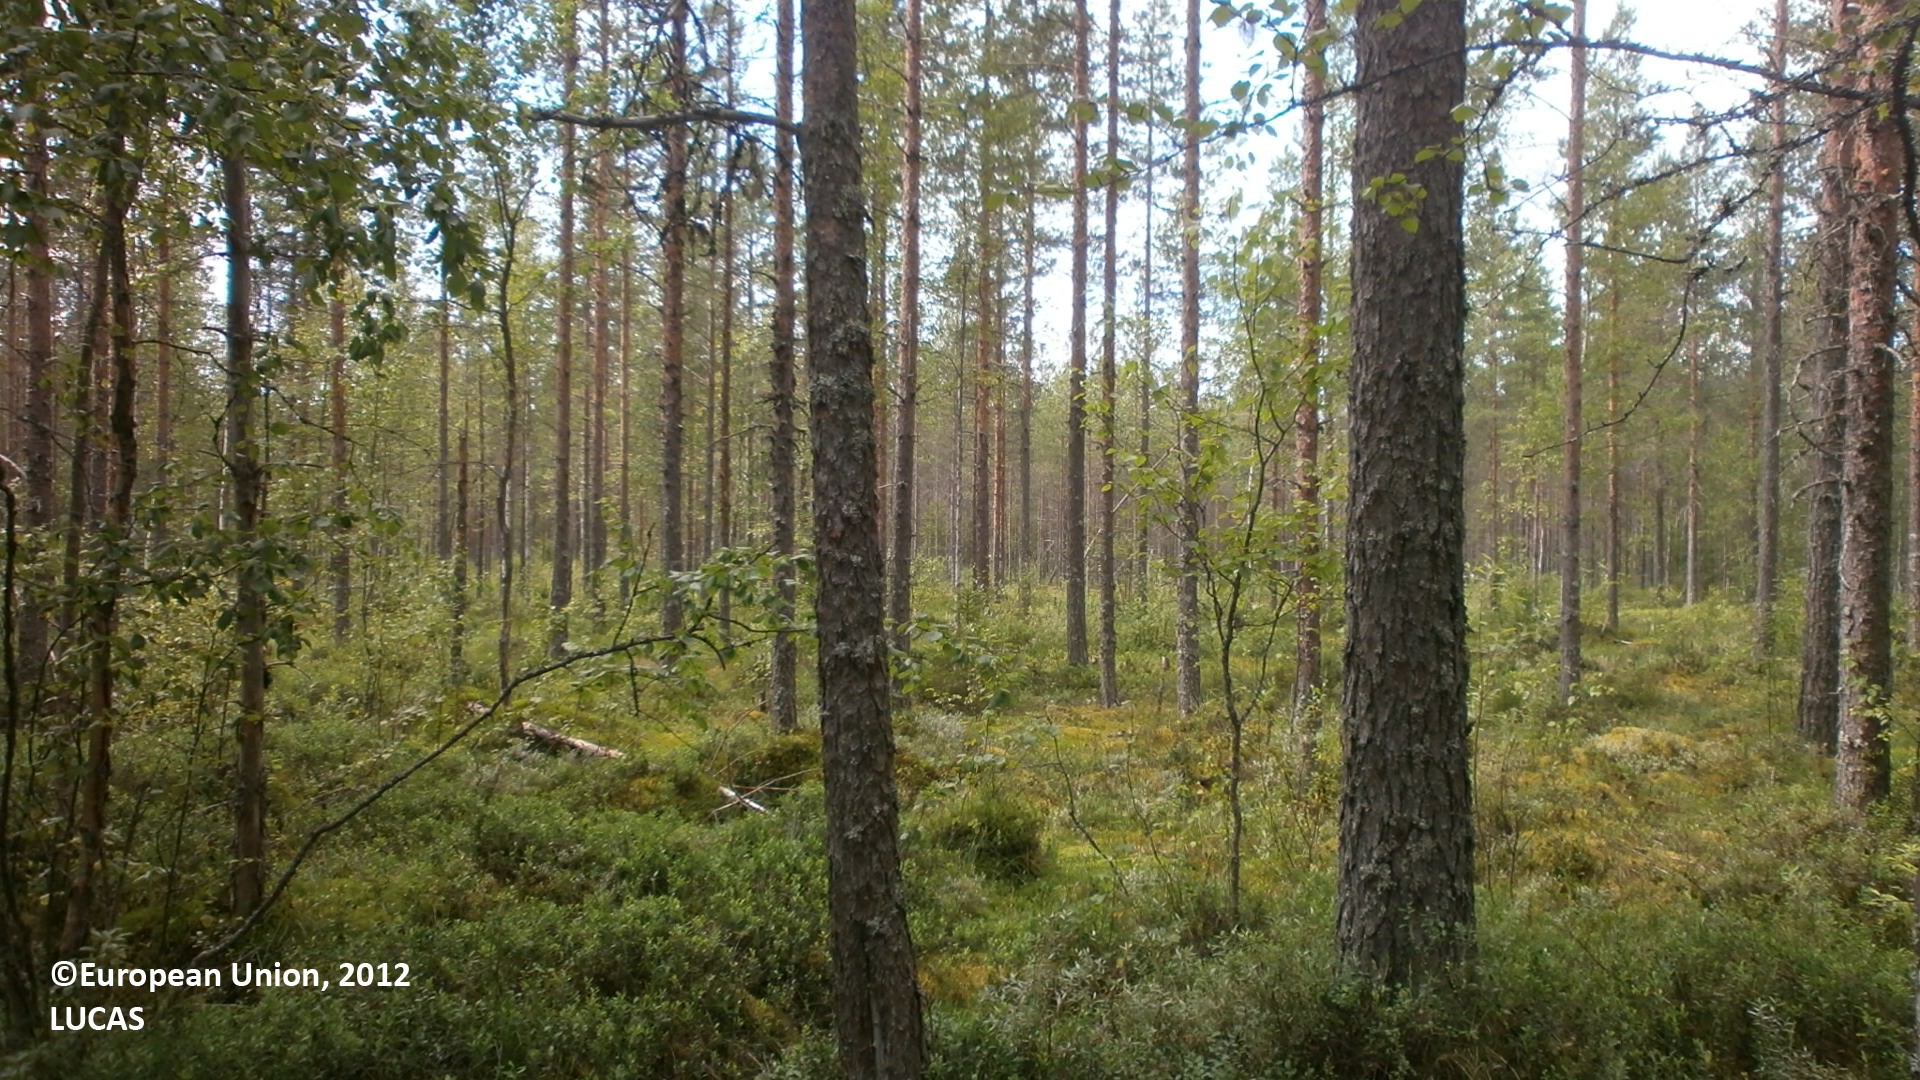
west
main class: Woodland
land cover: Pine dominated coniferous woodland
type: boreal forest
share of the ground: 50 - 75 %
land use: Forestry
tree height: > 5 m
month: July
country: FI
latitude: 64.1678
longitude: 24.9114
